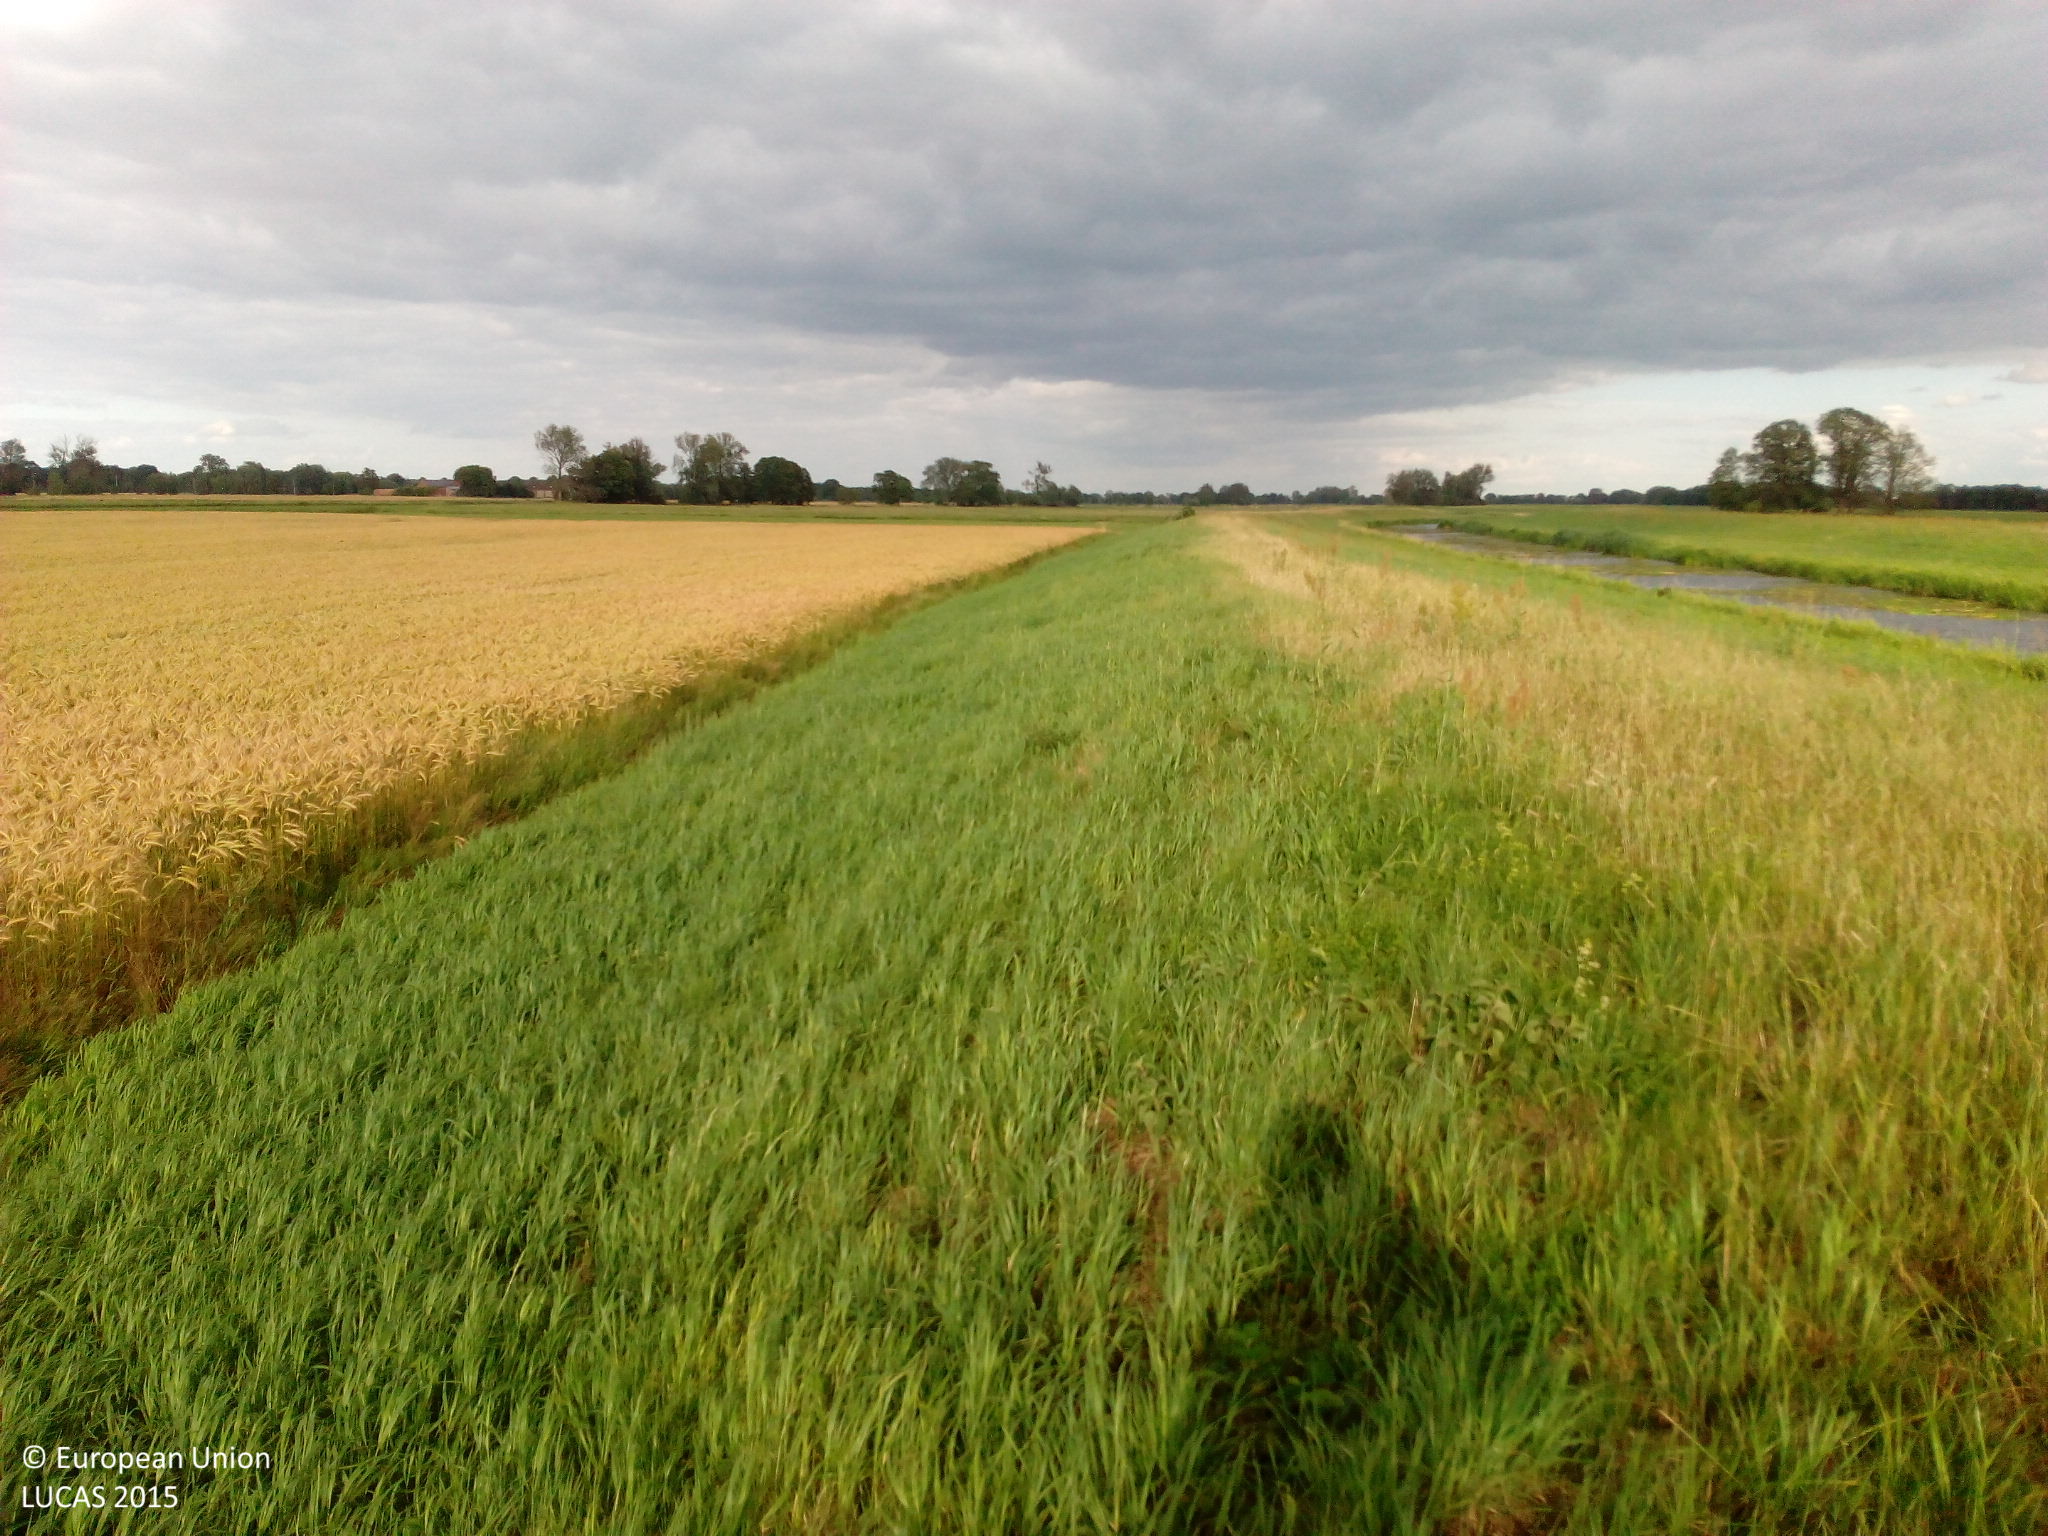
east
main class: Grassland
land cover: Grassland without tree/shrub cover
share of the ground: > 75 %
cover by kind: herbaceous plants 100 %
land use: Protection infrastructures
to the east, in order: Grassland without tree/shrub cover
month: July
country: DE
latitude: 52.7862
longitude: 12.3274
